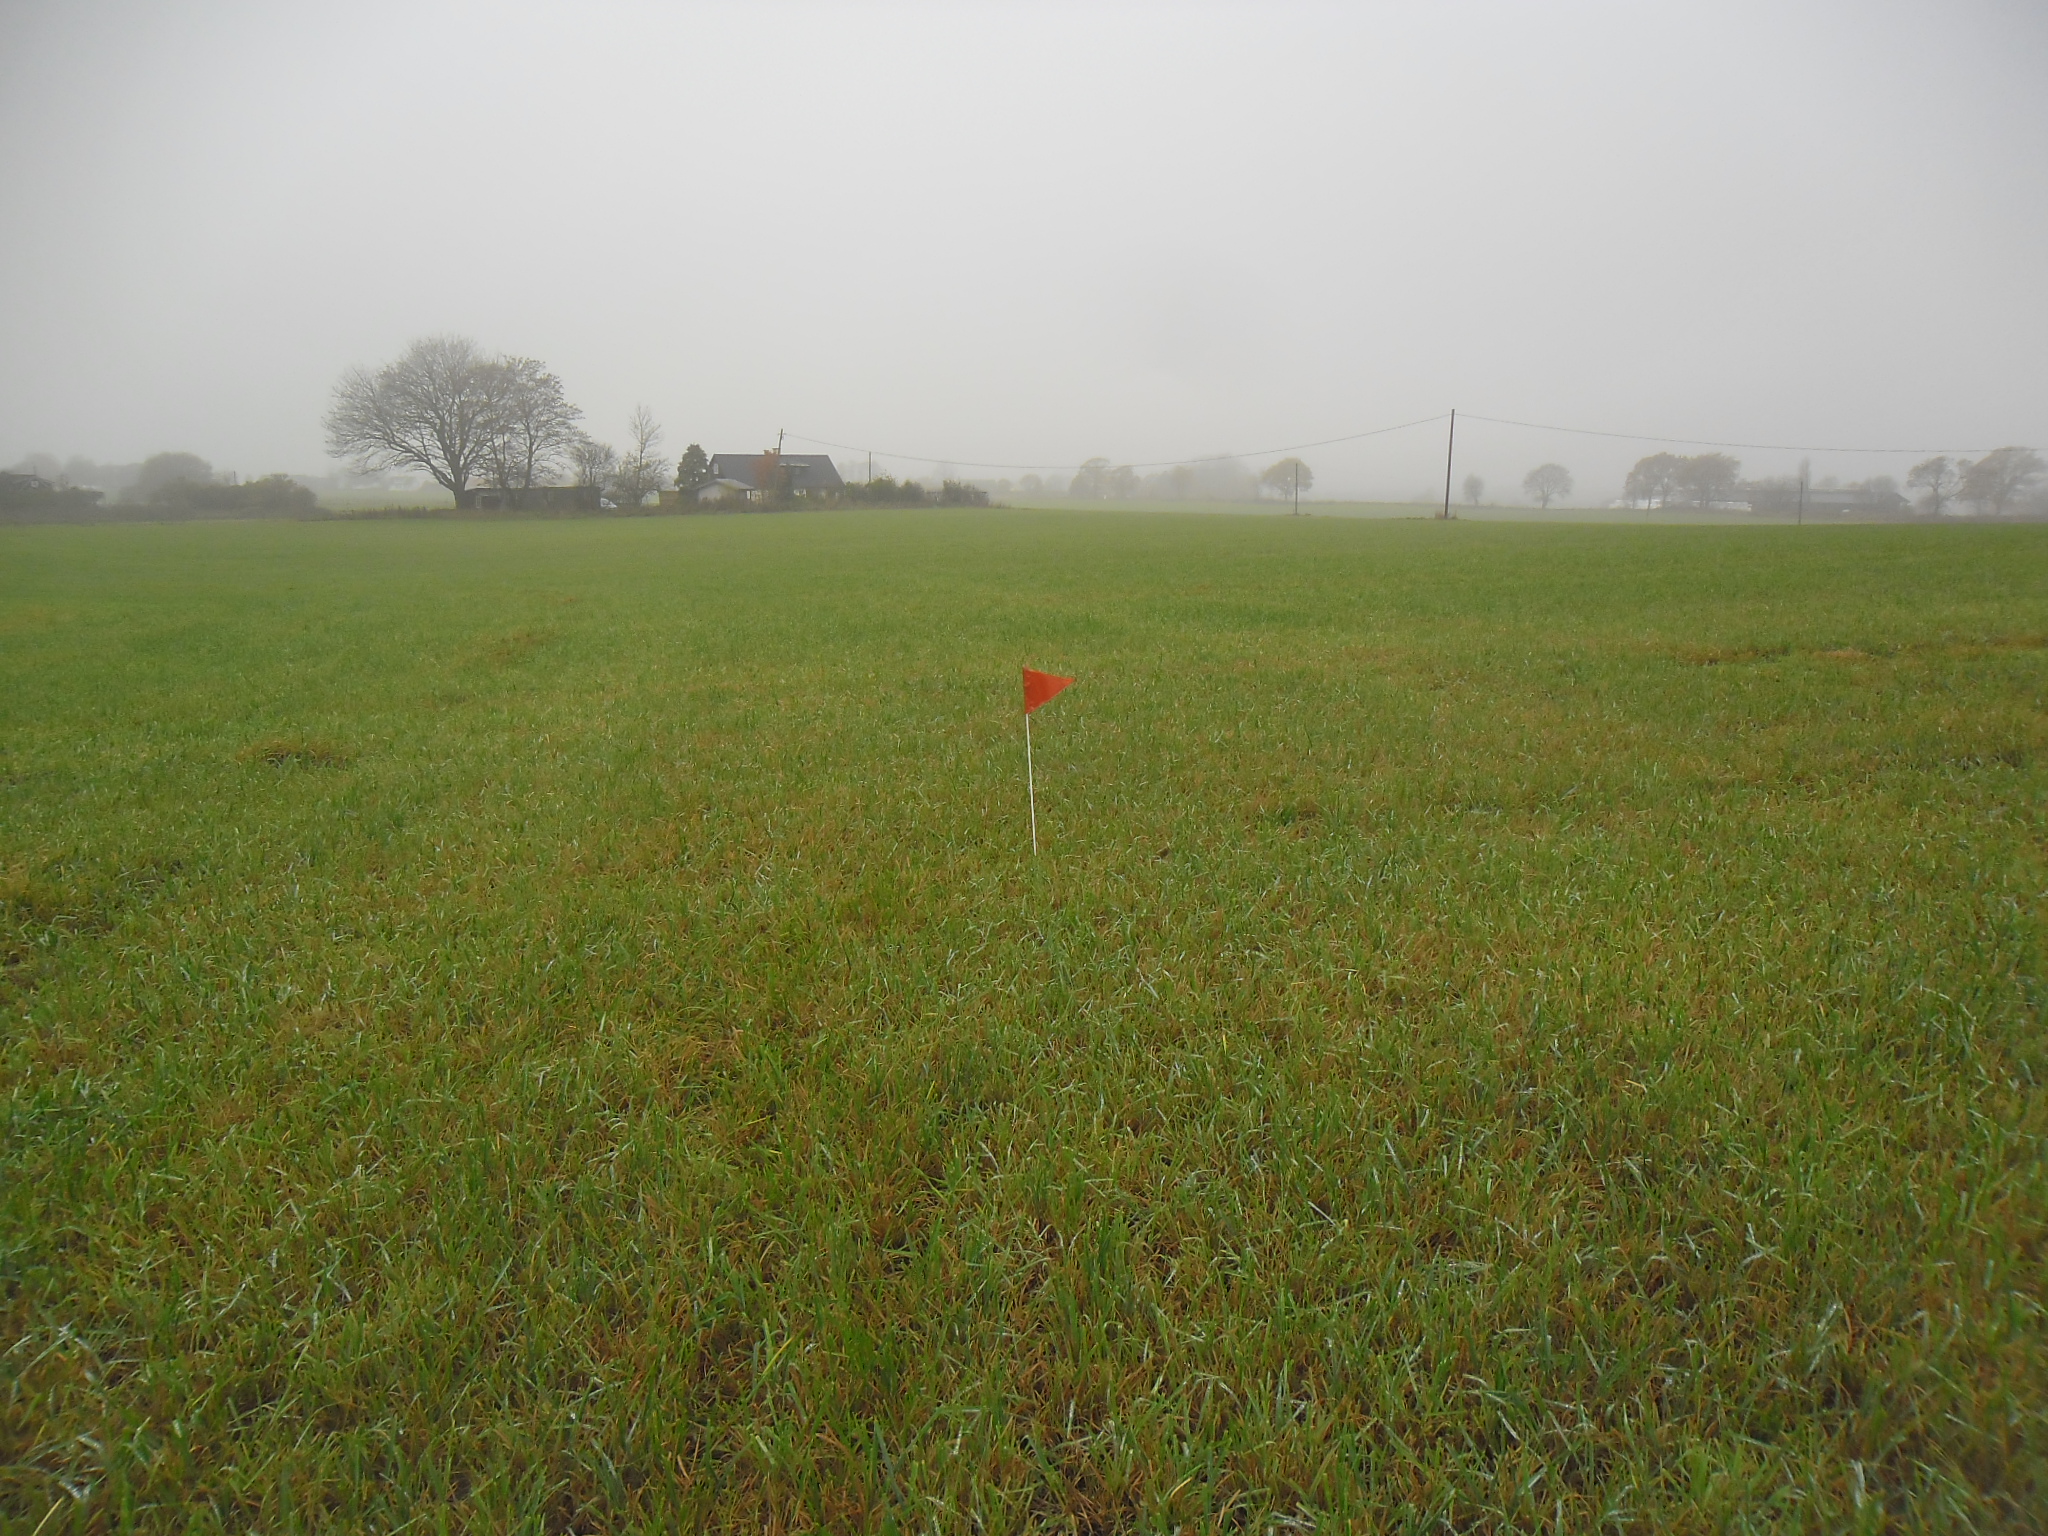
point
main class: Grassland
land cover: Grassland without tree/shrub cover
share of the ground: > 75 %
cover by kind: herbaceous plants 100 %
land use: Agriculture (excluding fallow land and kitchen gardens)
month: November
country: SE
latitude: 56.3731
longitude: 12.7983
